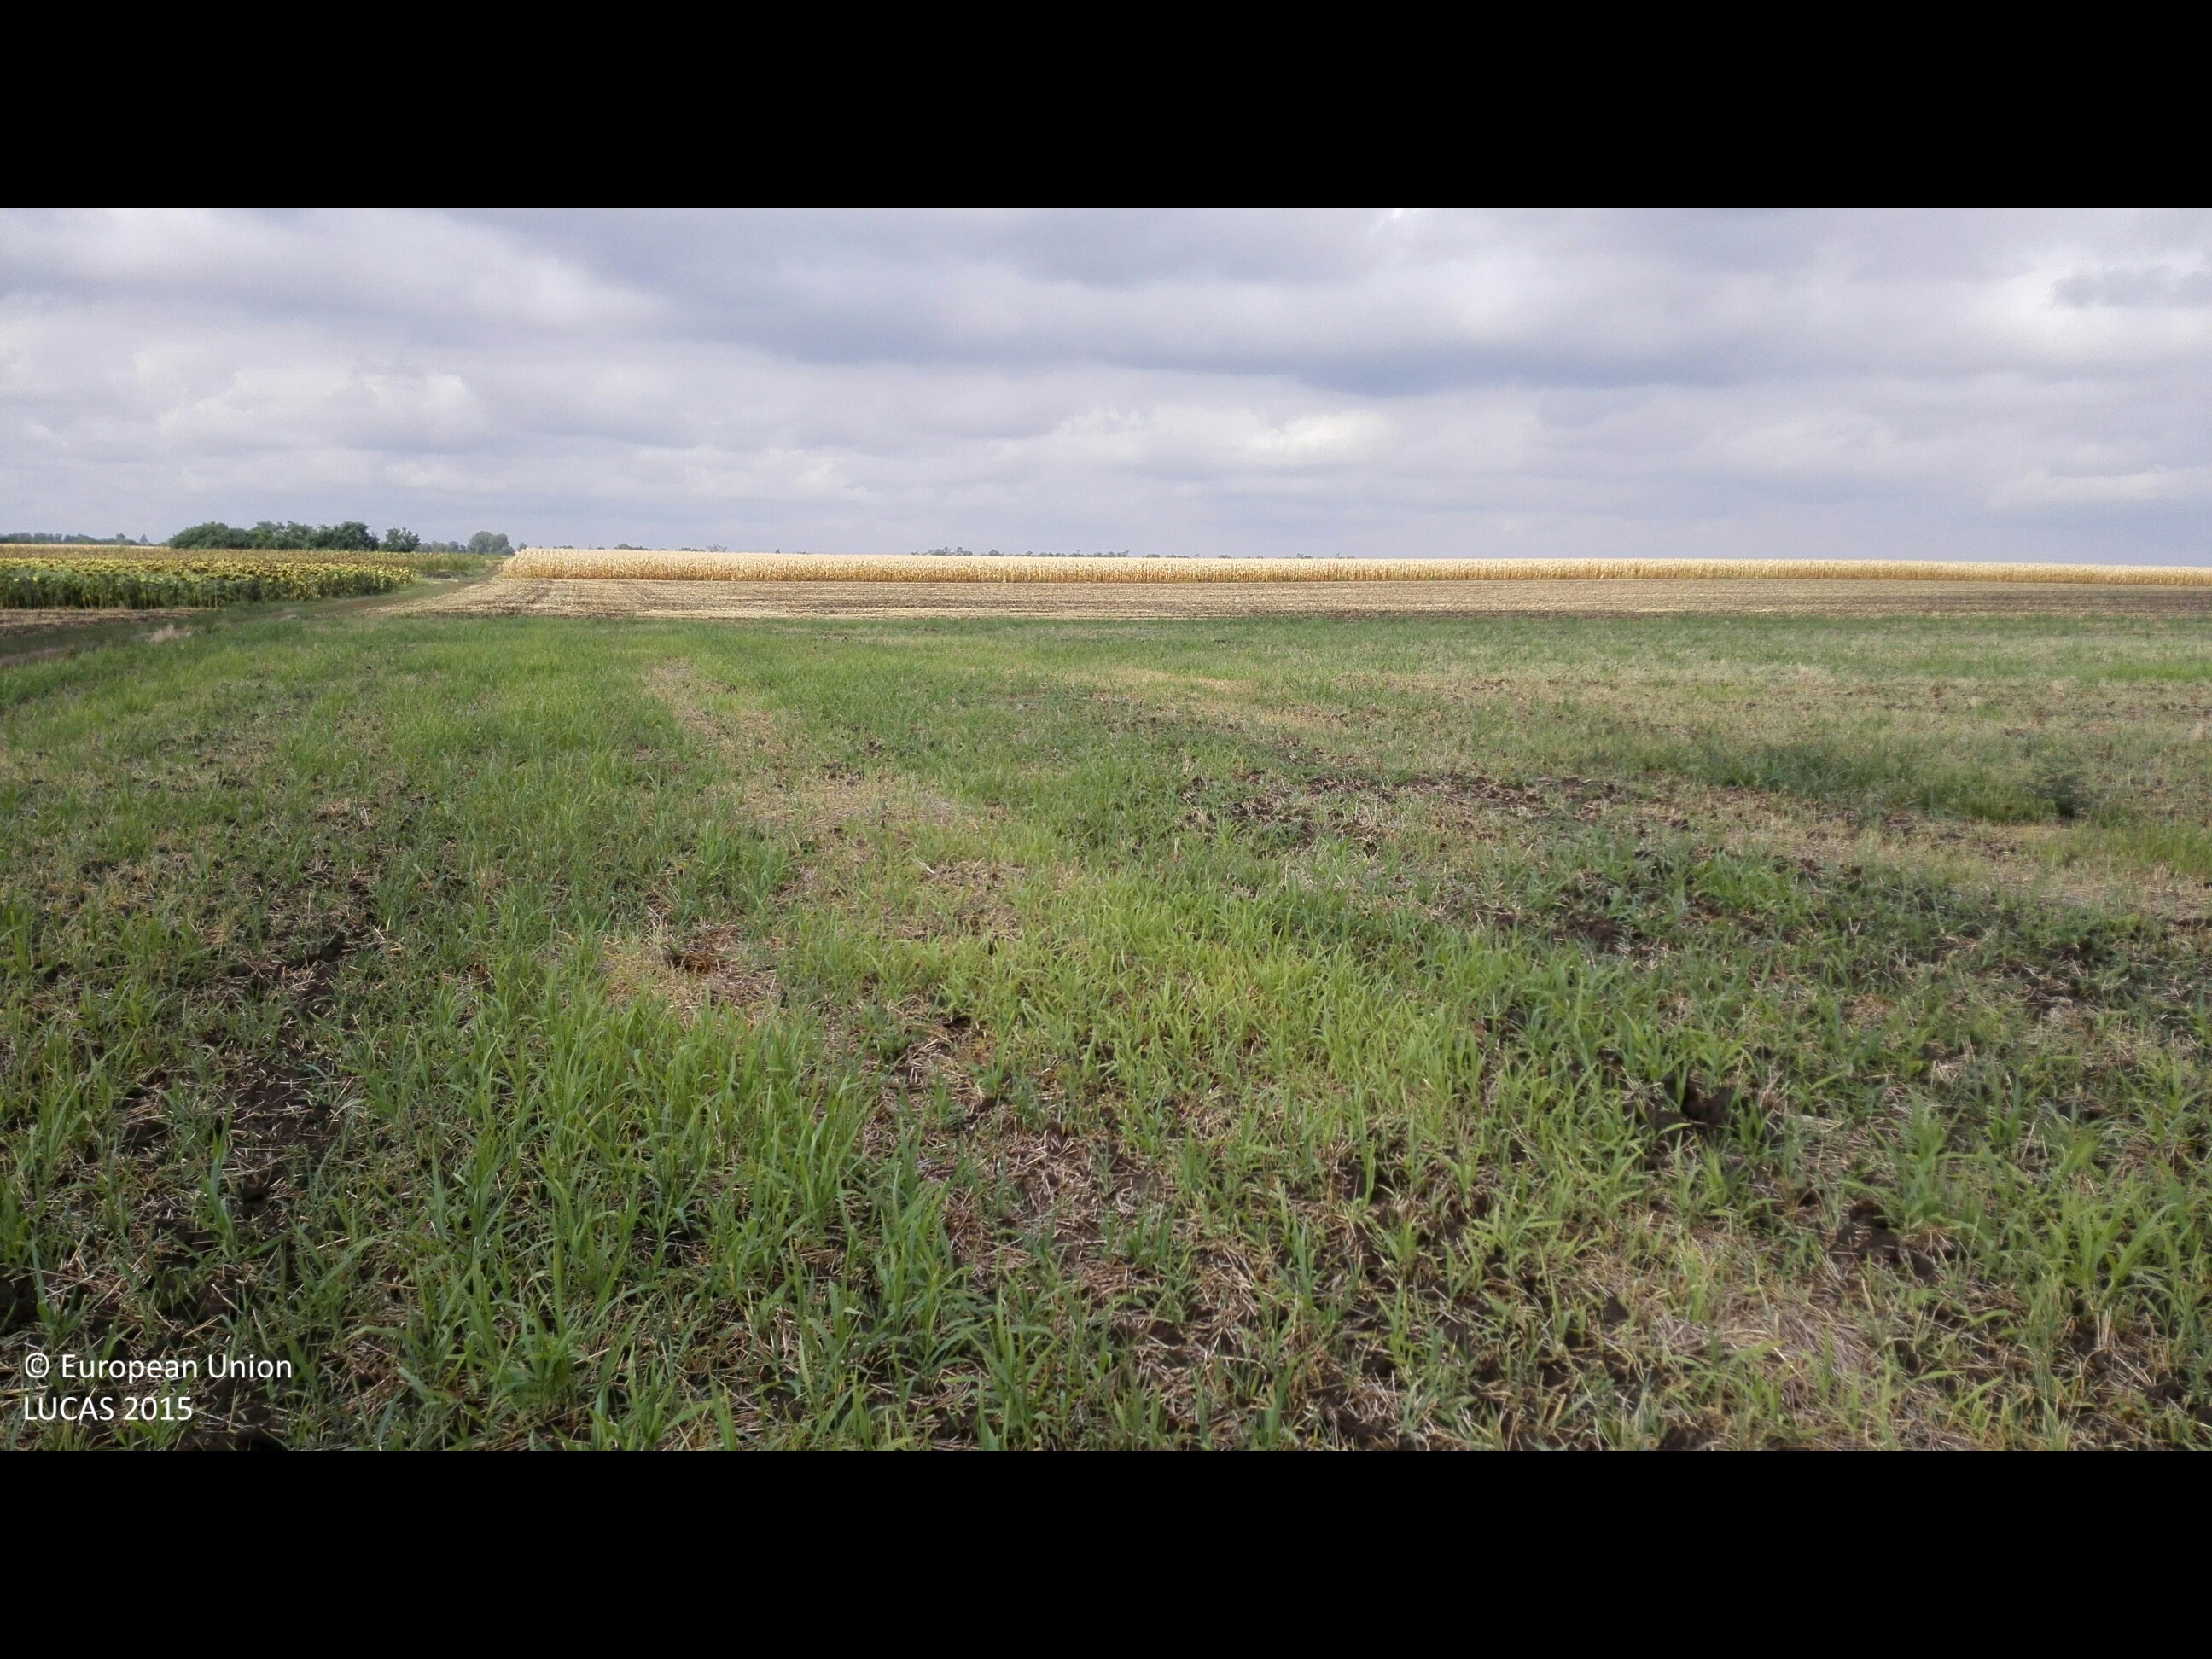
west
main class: Cropland
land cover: Common wheat
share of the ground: 10 - 25 %
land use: Agriculture (excluding fallow land and kitchen gardens)
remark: Harvested field
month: August
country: HU
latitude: 47.3344
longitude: 21.7841
